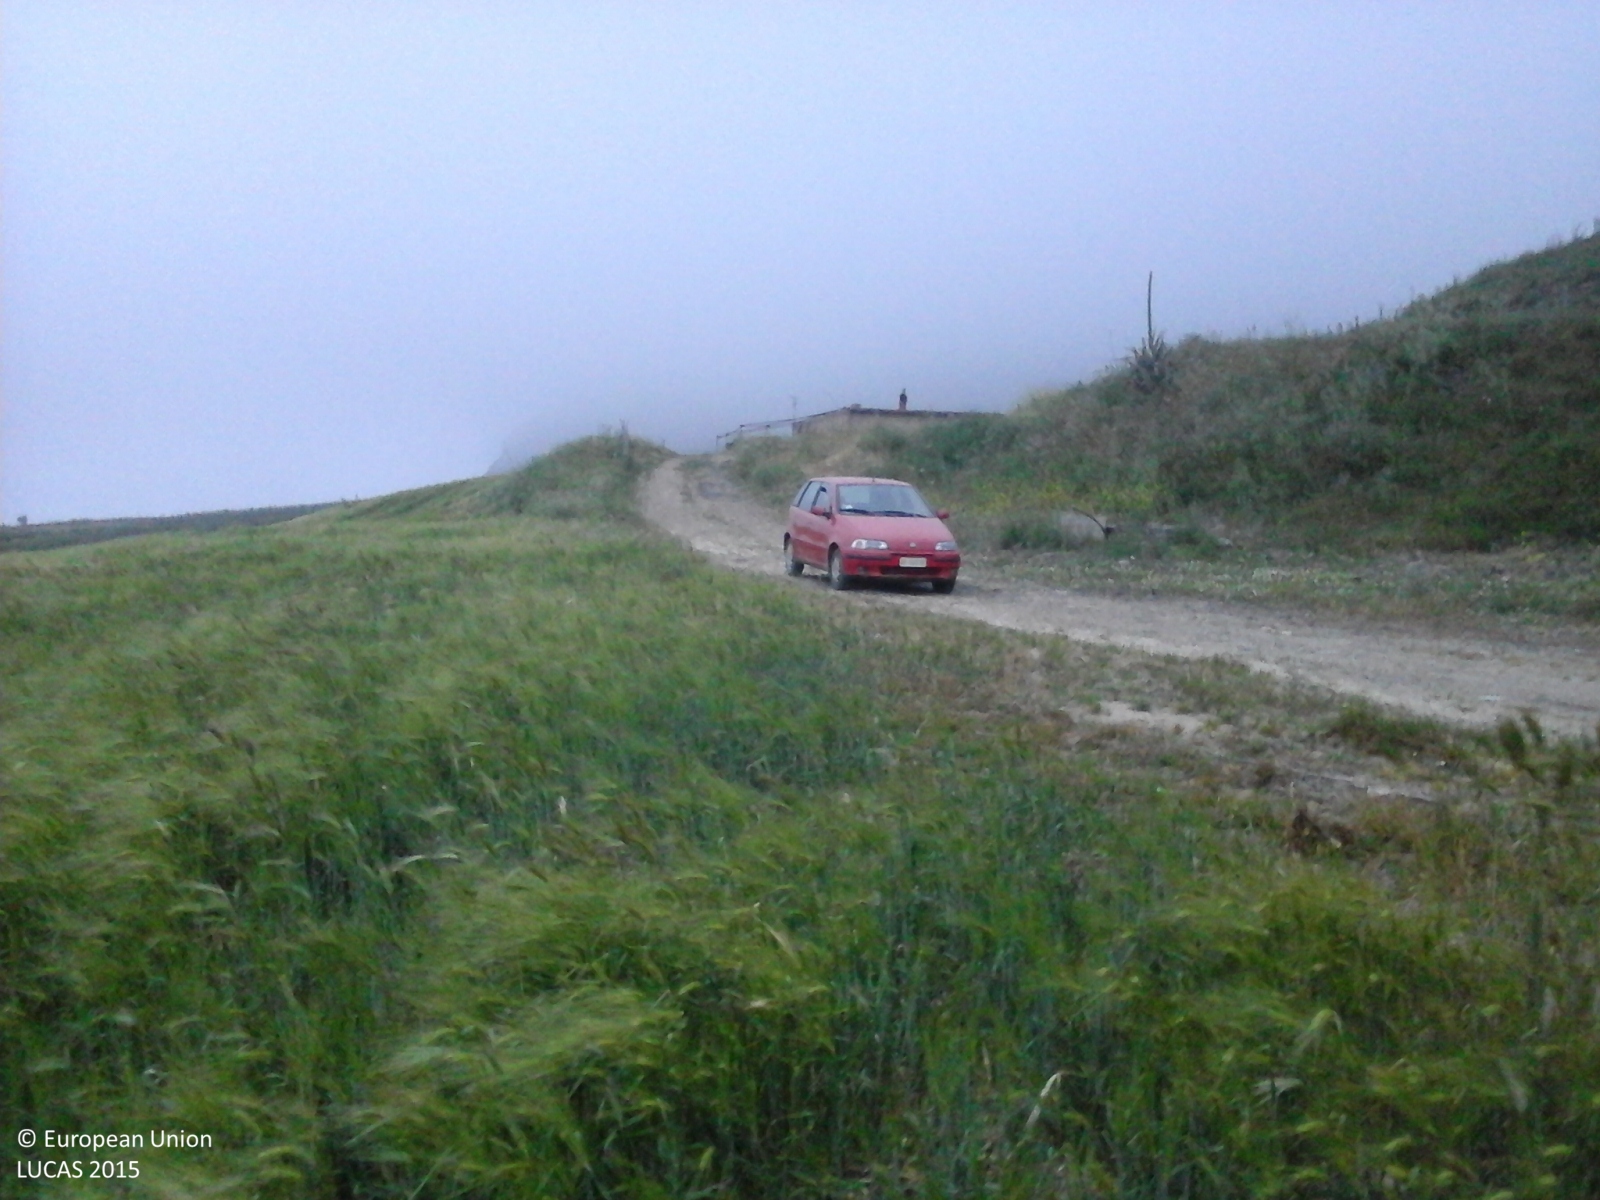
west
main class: Cropland
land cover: Barley
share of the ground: > 75 %
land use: Agriculture (excluding fallow land and kitchen gardens)
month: May
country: IT
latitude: 37.7542
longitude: 14.0004
